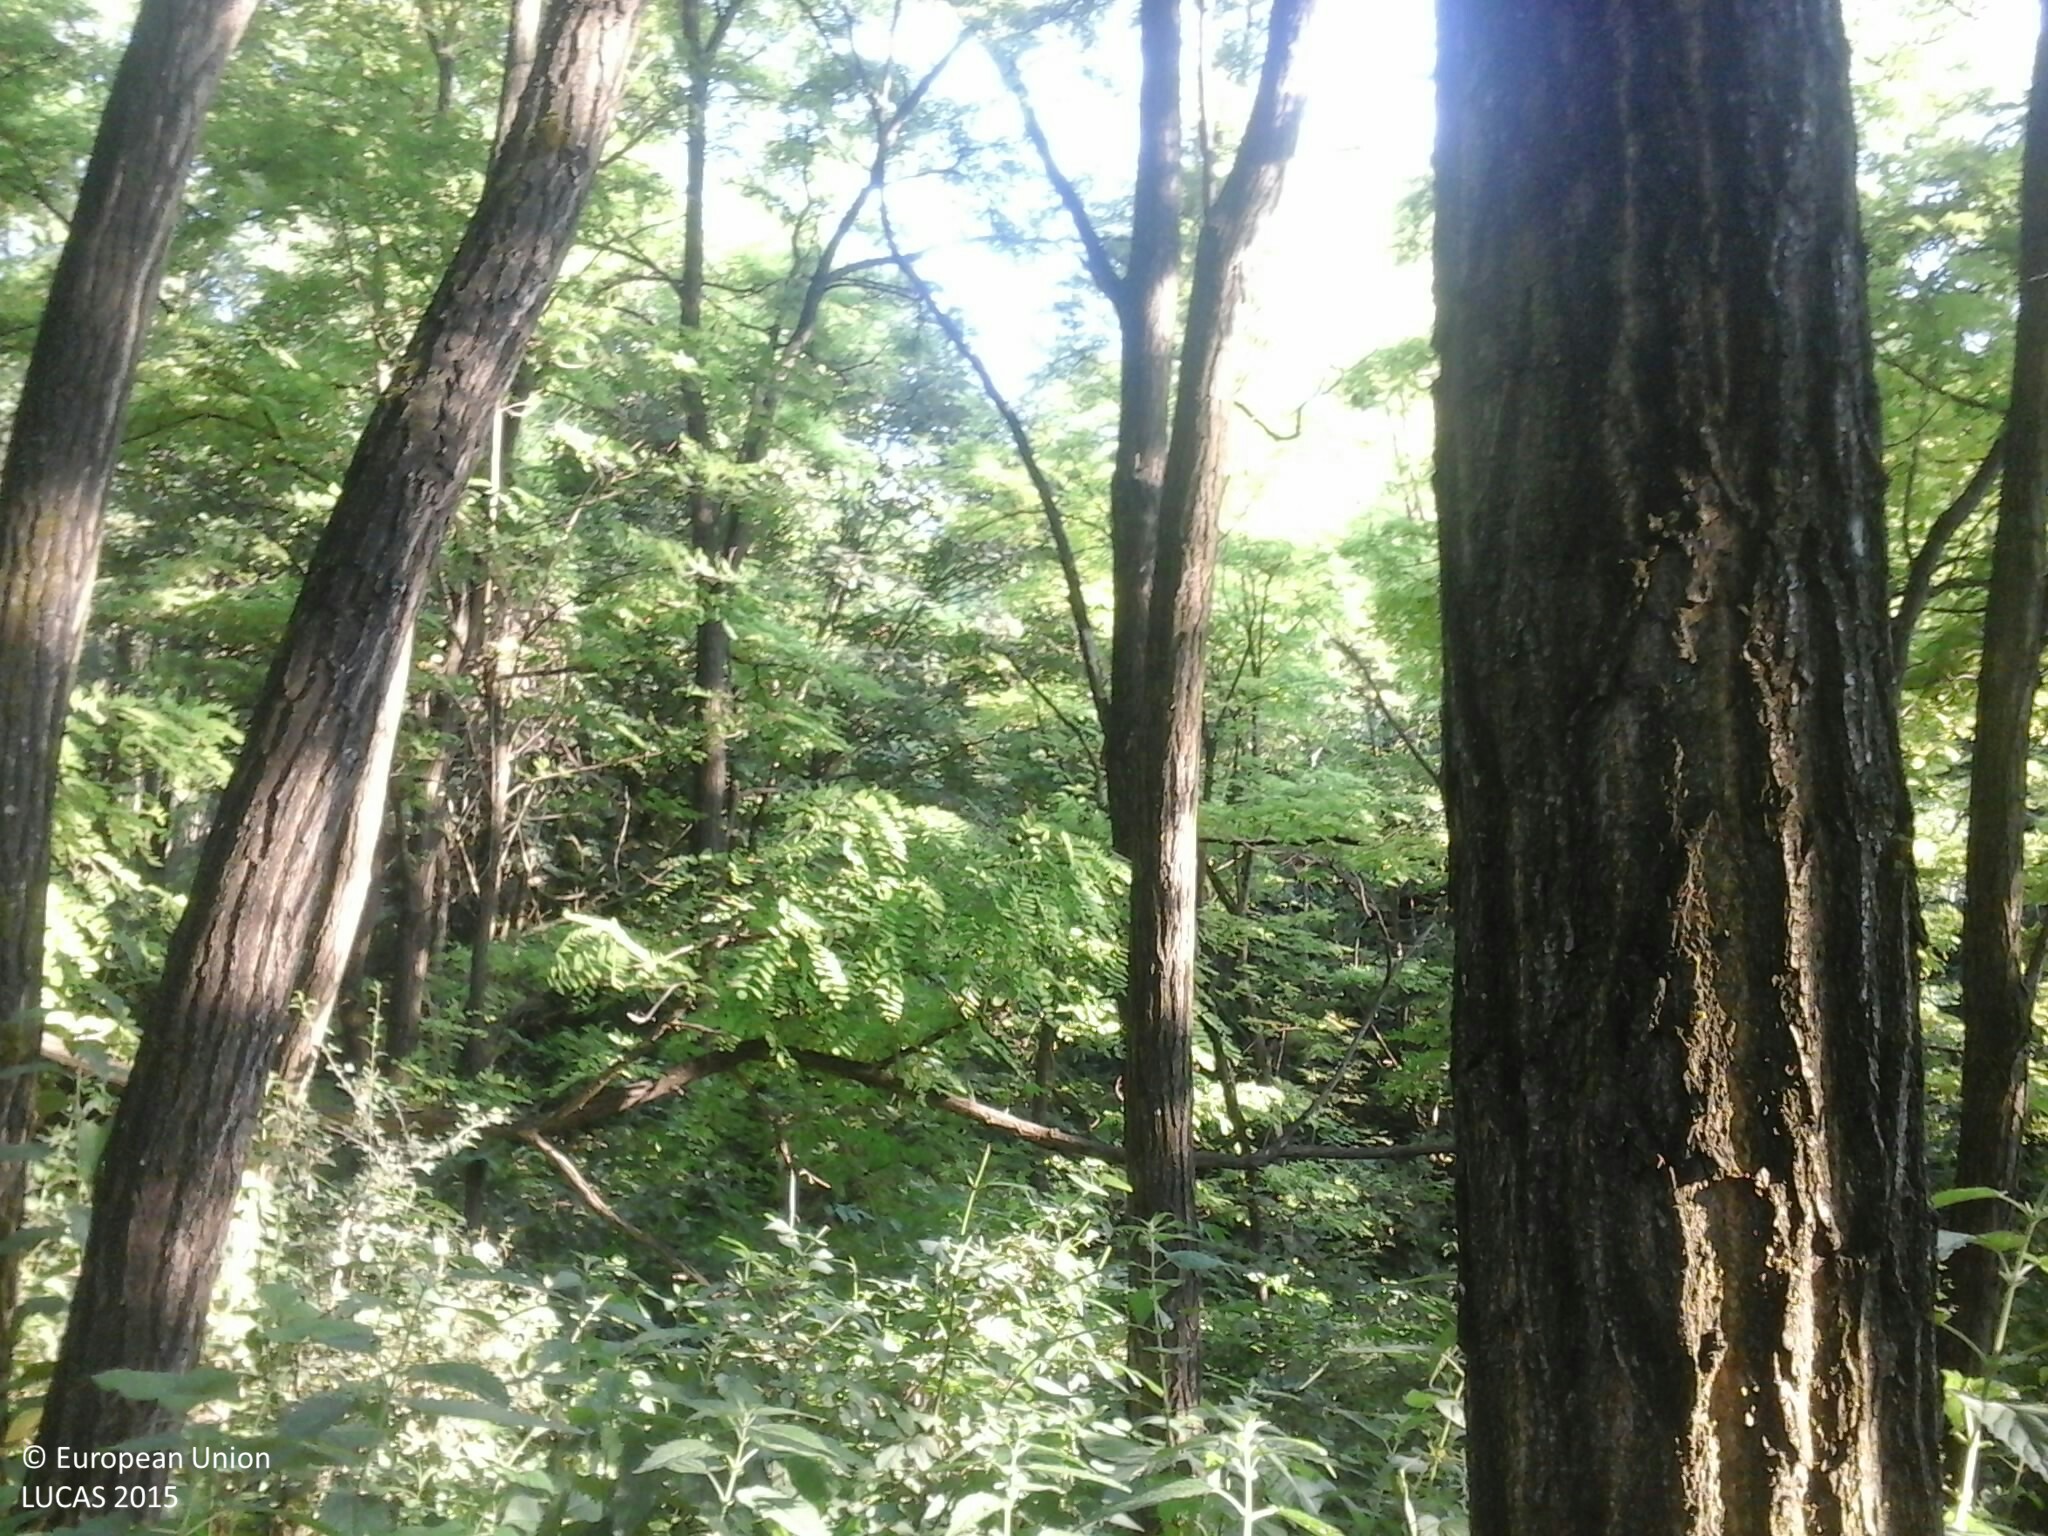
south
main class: Woodland
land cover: Broadleaved woodland
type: exotic forest
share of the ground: > 75 %
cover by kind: broadleaved forest trees 90 %, shrubs 10 %
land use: Forestry
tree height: > 5 m
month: July
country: HU
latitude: 47.3659
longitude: 17.8352
